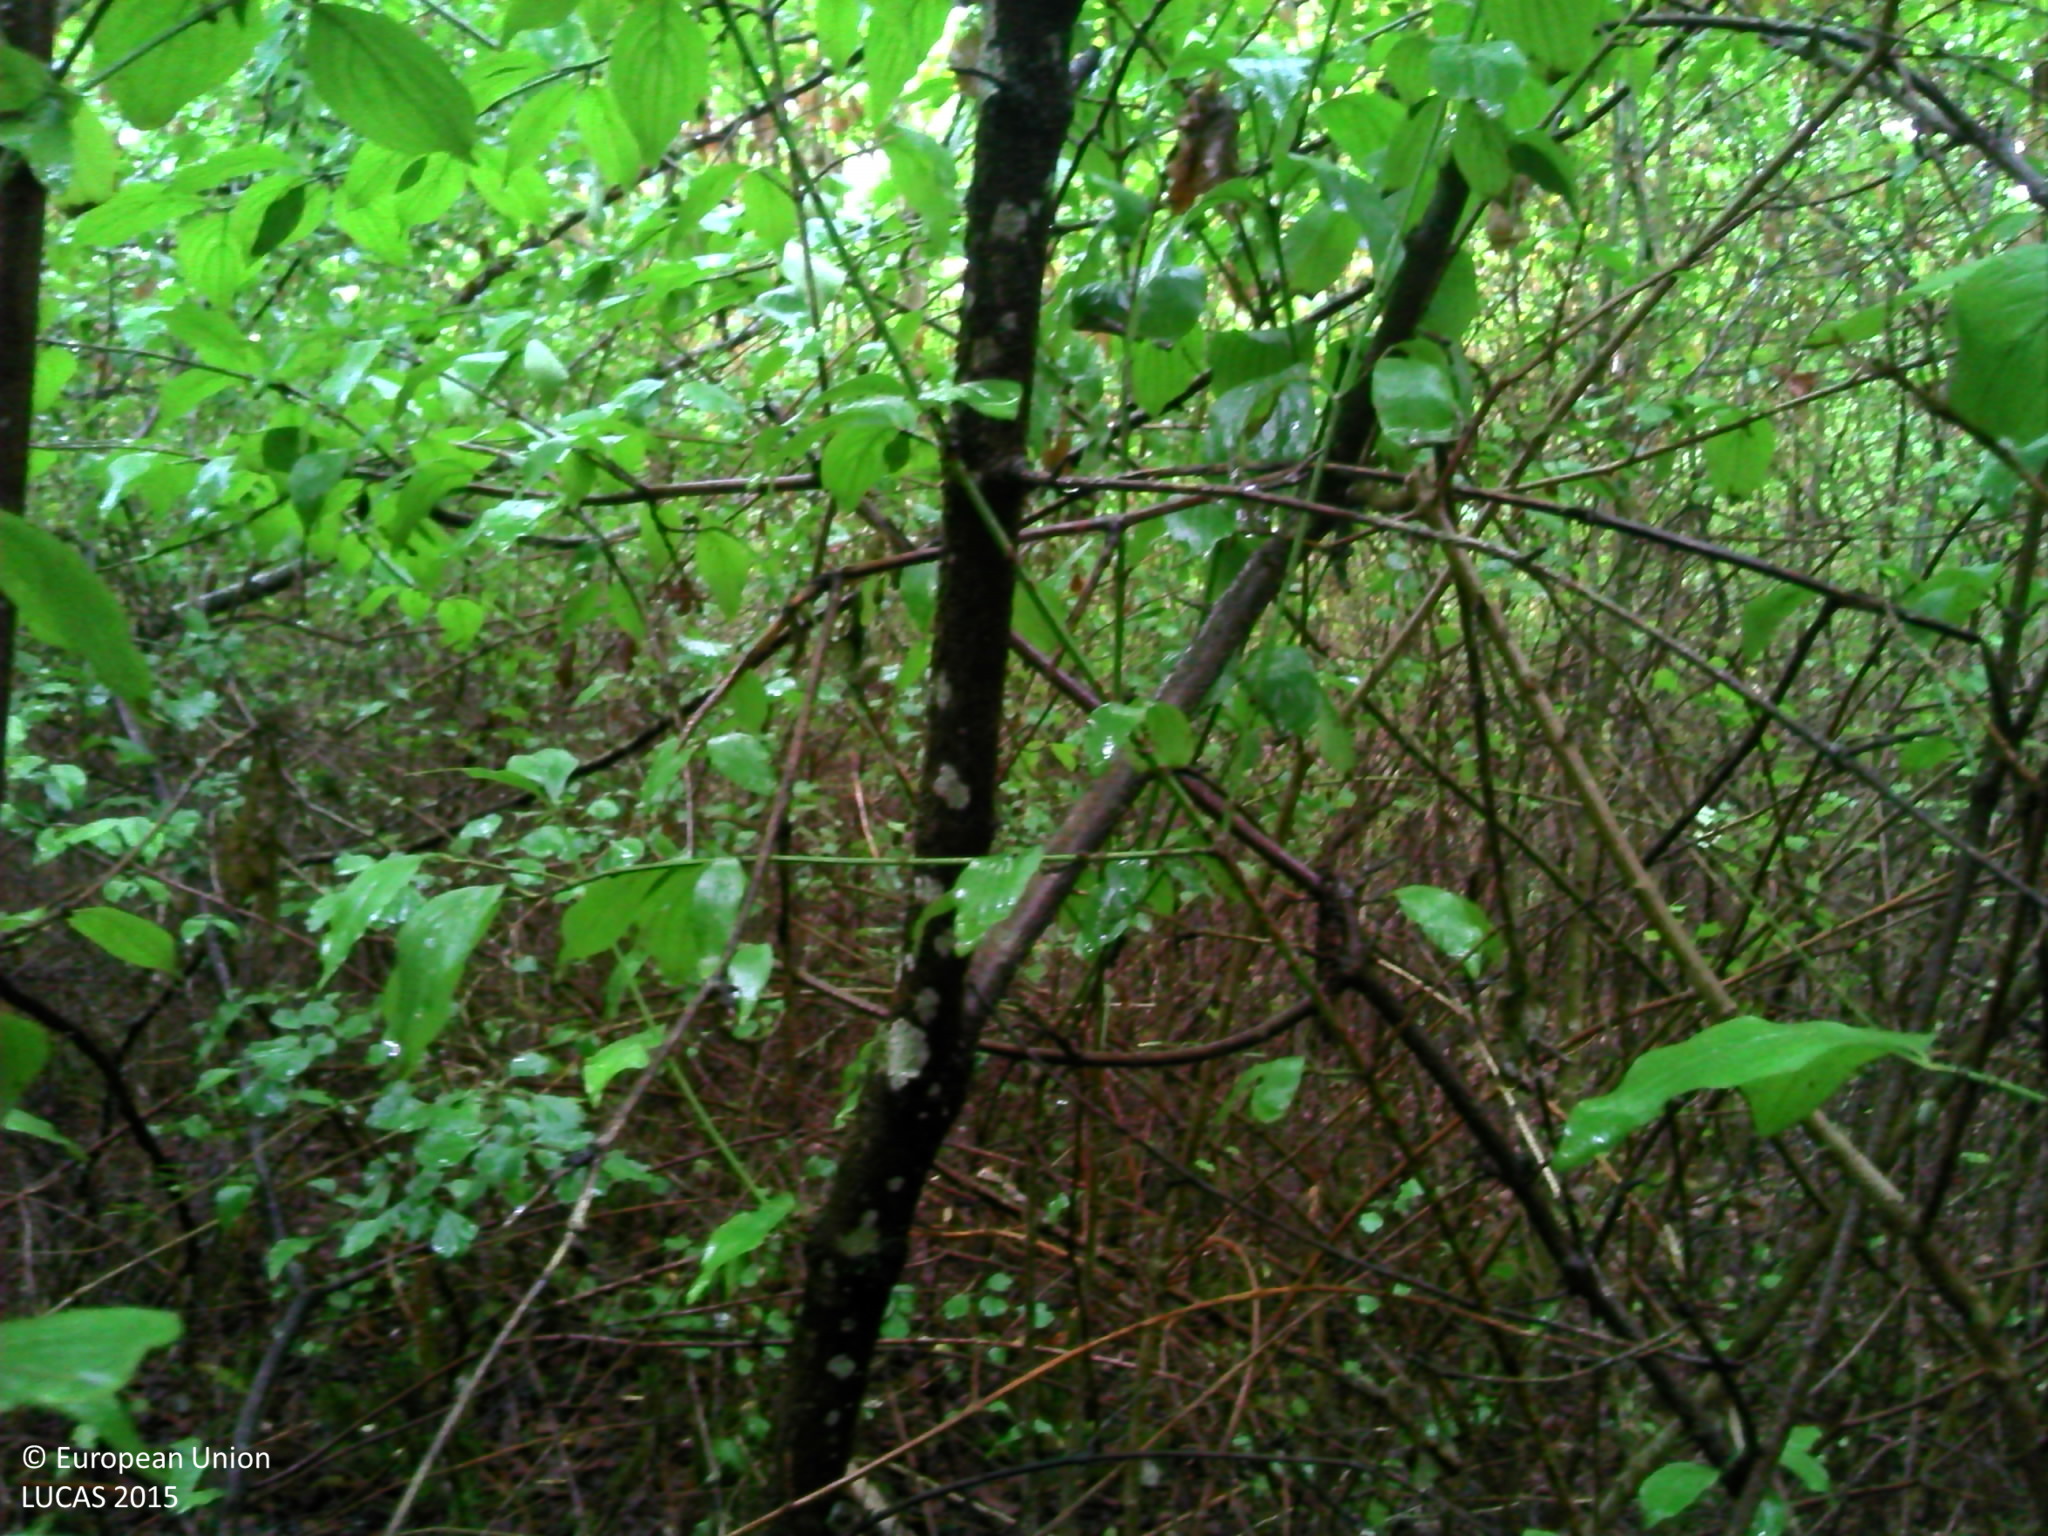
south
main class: Woodland
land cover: Broadleaved woodland
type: mesophytic deciduous forest
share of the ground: > 75 %
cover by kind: broadleaved forest trees 80 %, shrubs 15 %, herbaceous plants 5 %
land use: Forestry
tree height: > 5 m
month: September
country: FR
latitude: 47.1049
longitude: 4.7164
